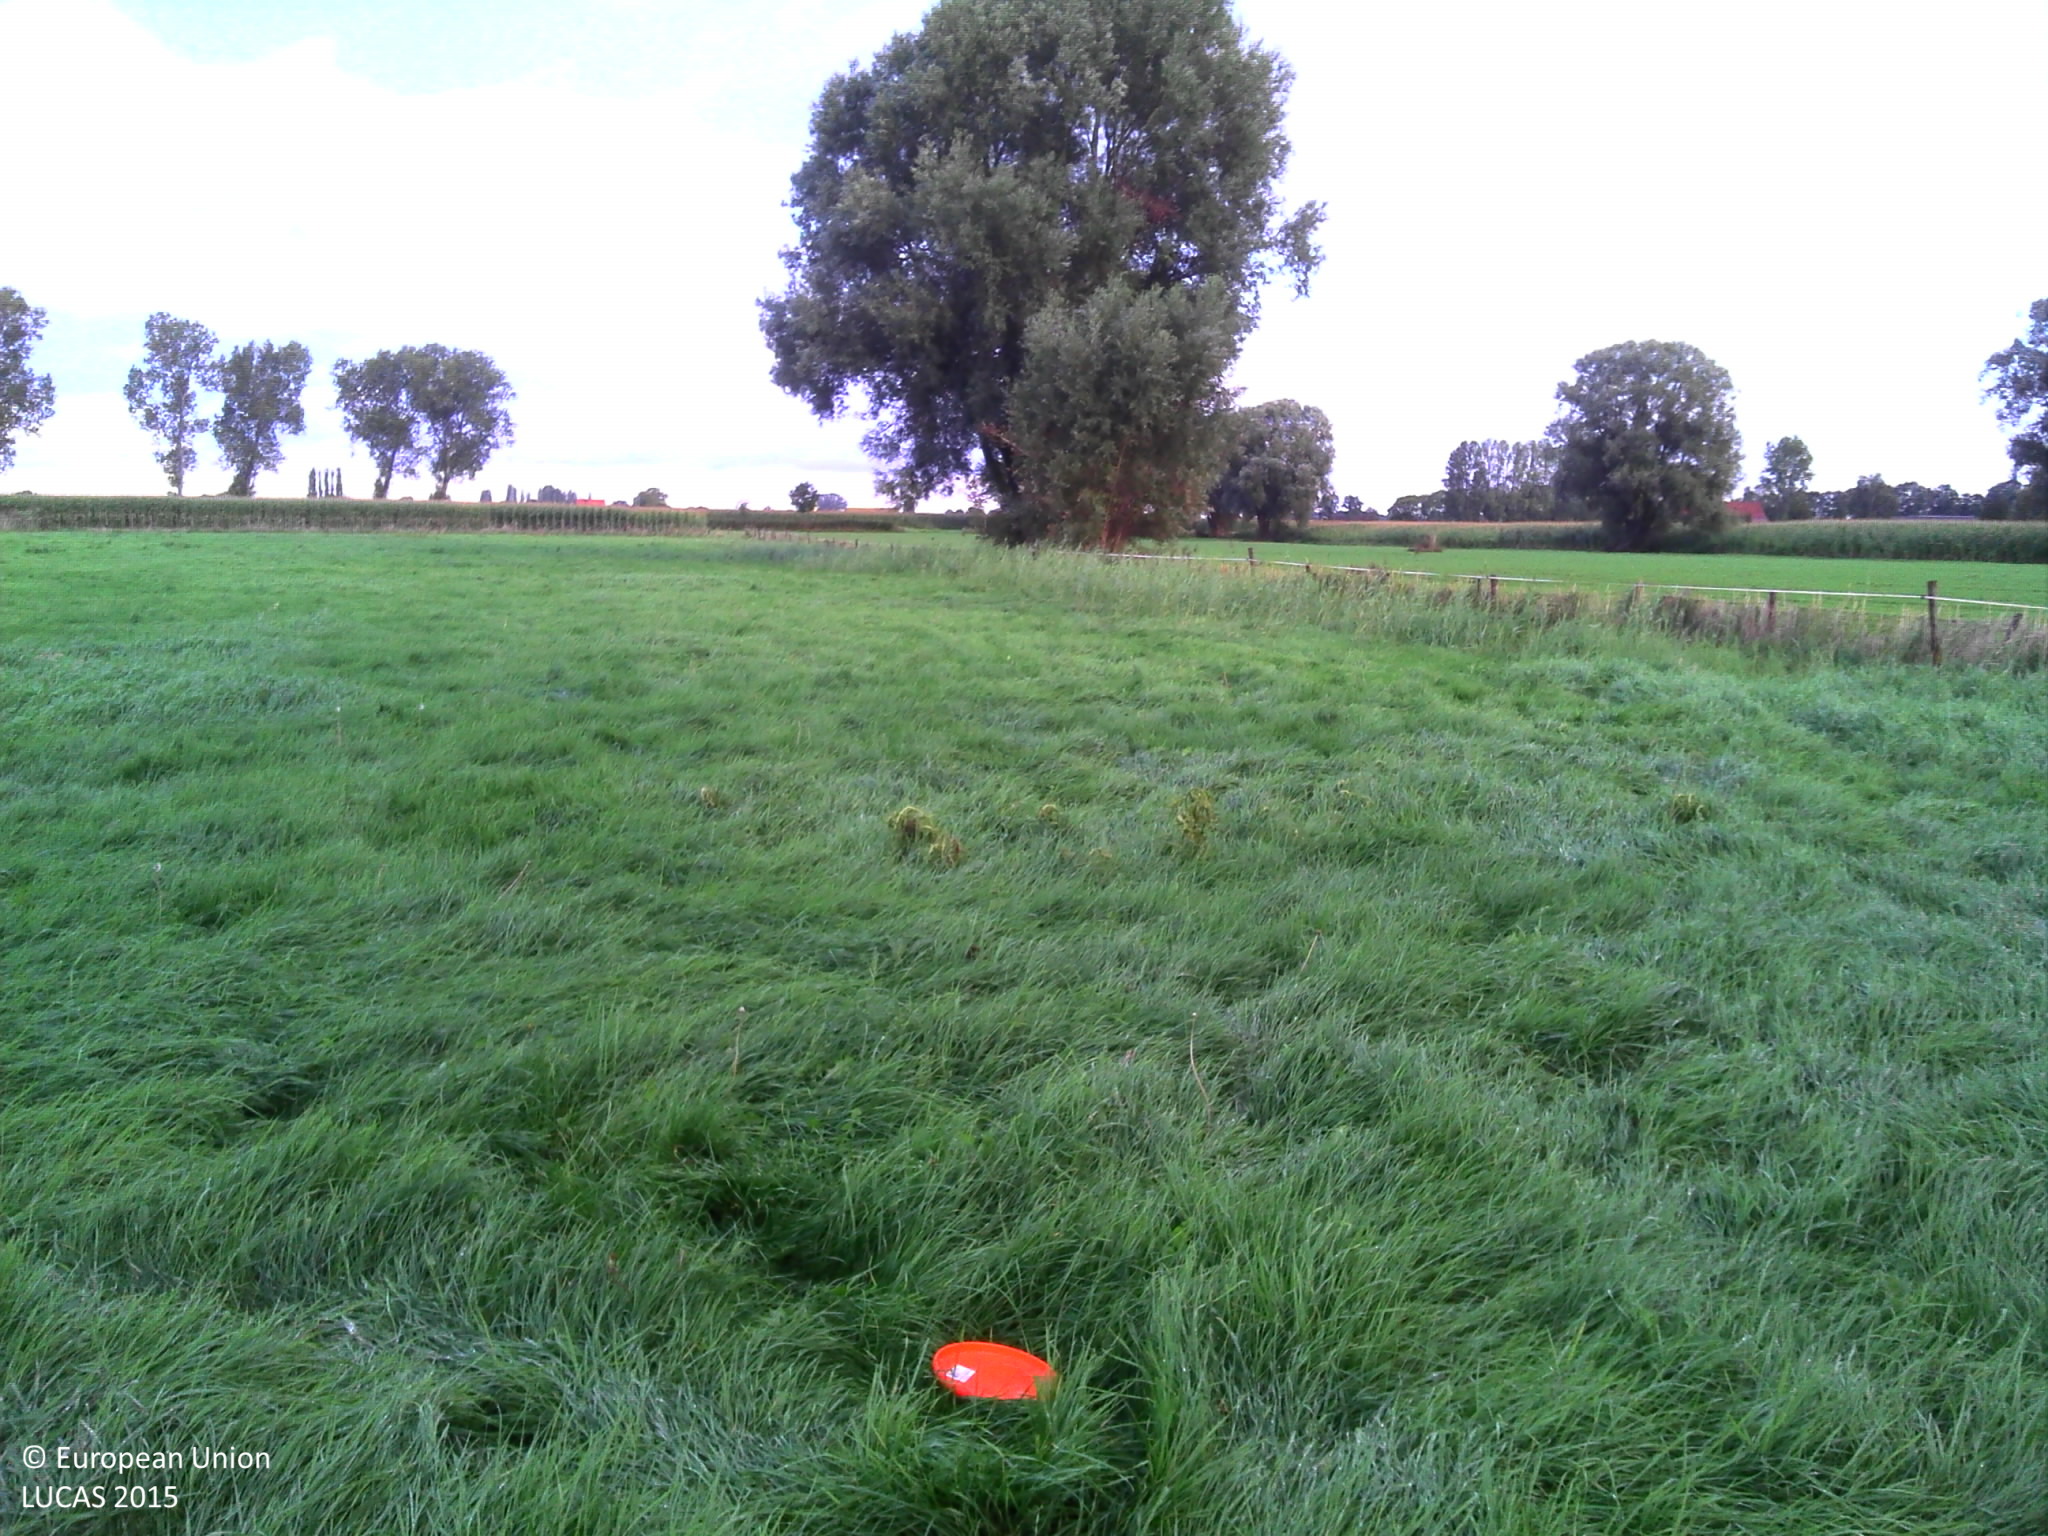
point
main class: Grassland
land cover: Grassland without tree/shrub cover
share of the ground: > 75 %
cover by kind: herbaceous plants 100 %
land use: Agriculture (excluding fallow land and kitchen gardens)
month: September
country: BE
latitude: 51.4094
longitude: 4.6336
